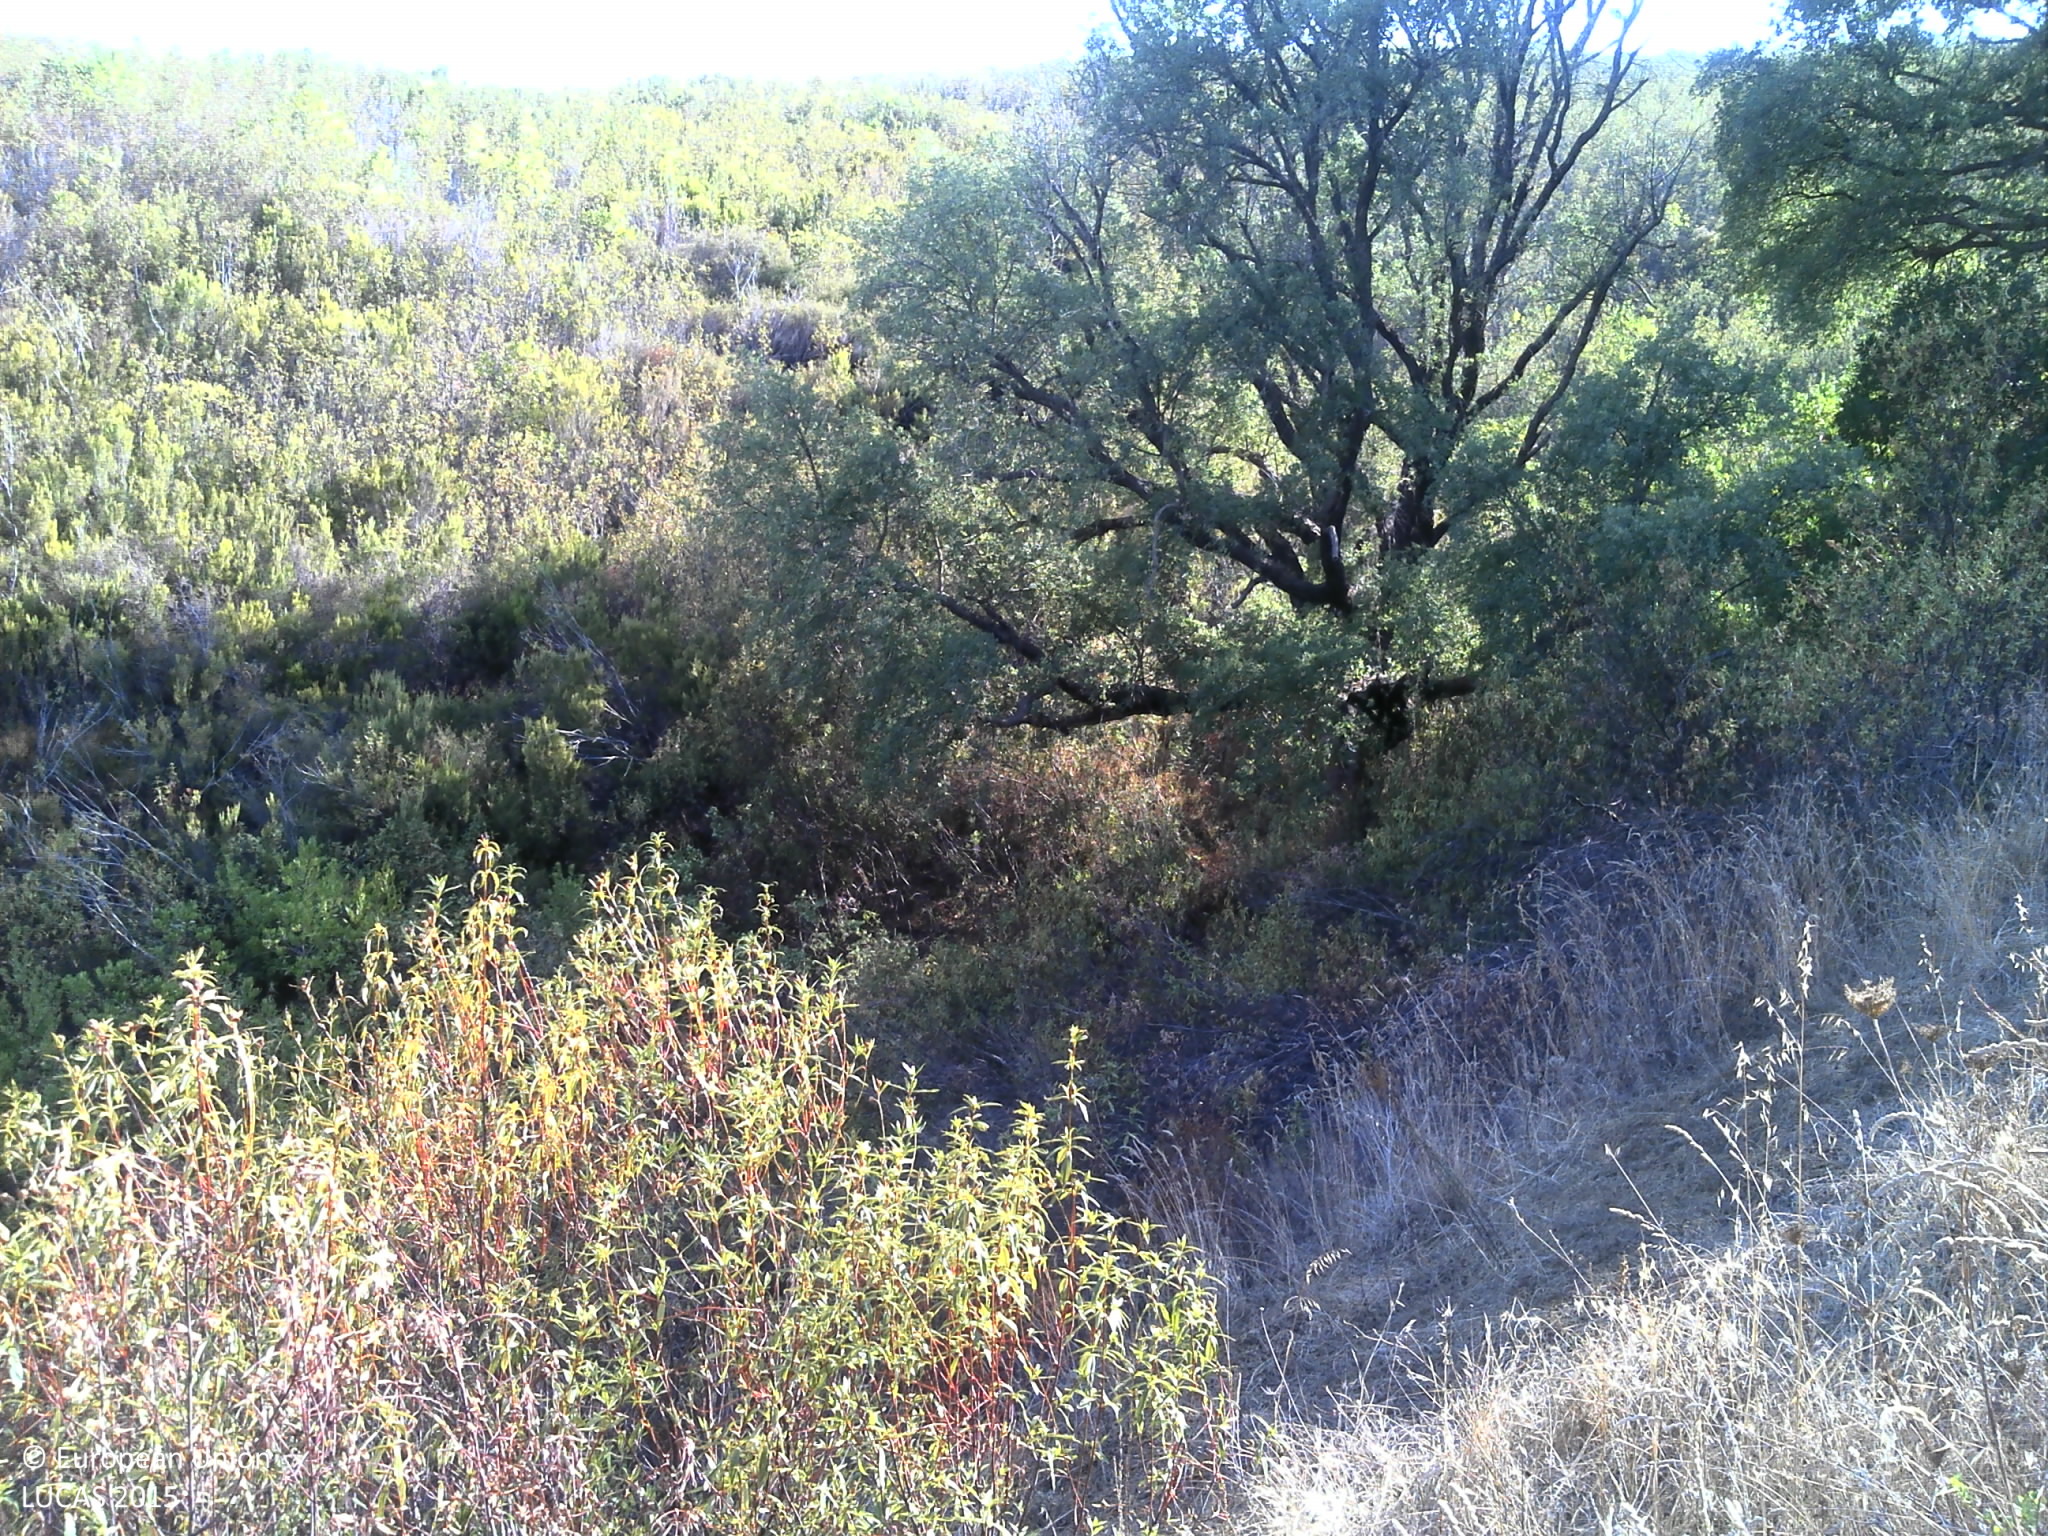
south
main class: Shrubland
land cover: Shrubland without tree cover
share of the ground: > 75 %
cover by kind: shrubs 75 %, herbaceous plants 20 %, unconsolidated bare surface 5 %
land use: Abandoned areas
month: September
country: PT
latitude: 37.3355
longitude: -8.1585
